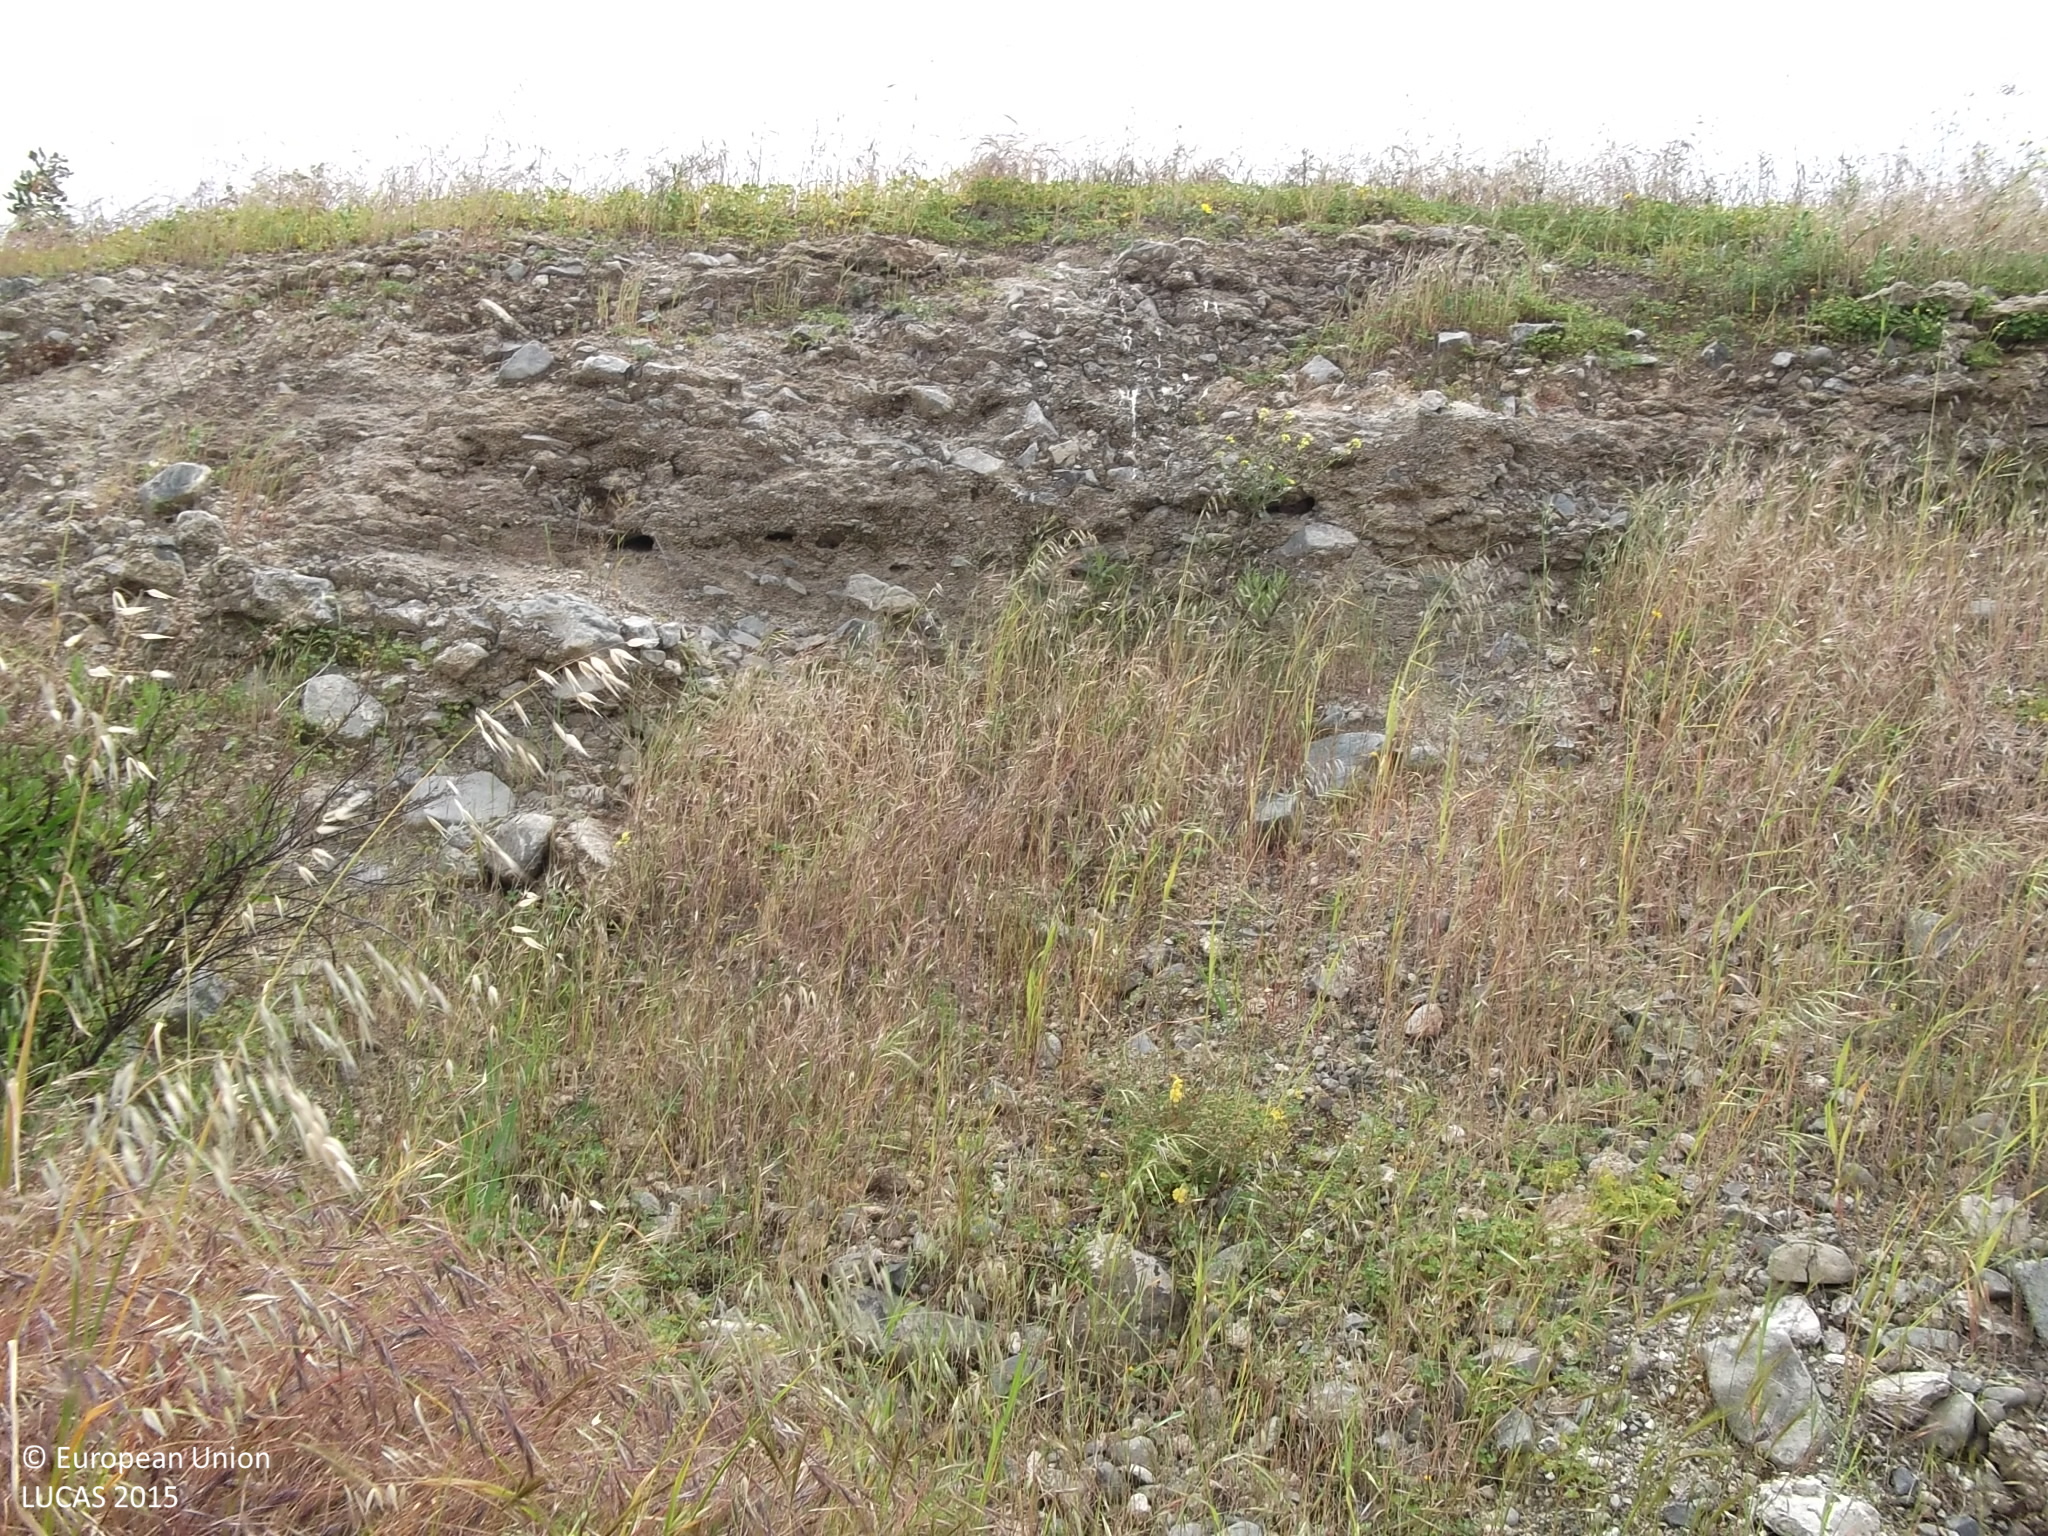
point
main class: Grassland
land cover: Spontaneously vegetated surfaces
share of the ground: > 75 %
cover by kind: herbaceous plants 85 %, unconsolidated bare surface 15 %
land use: Semi-natural and natural areas not in use
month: April
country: CY
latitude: 34.8415
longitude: 33.4694
